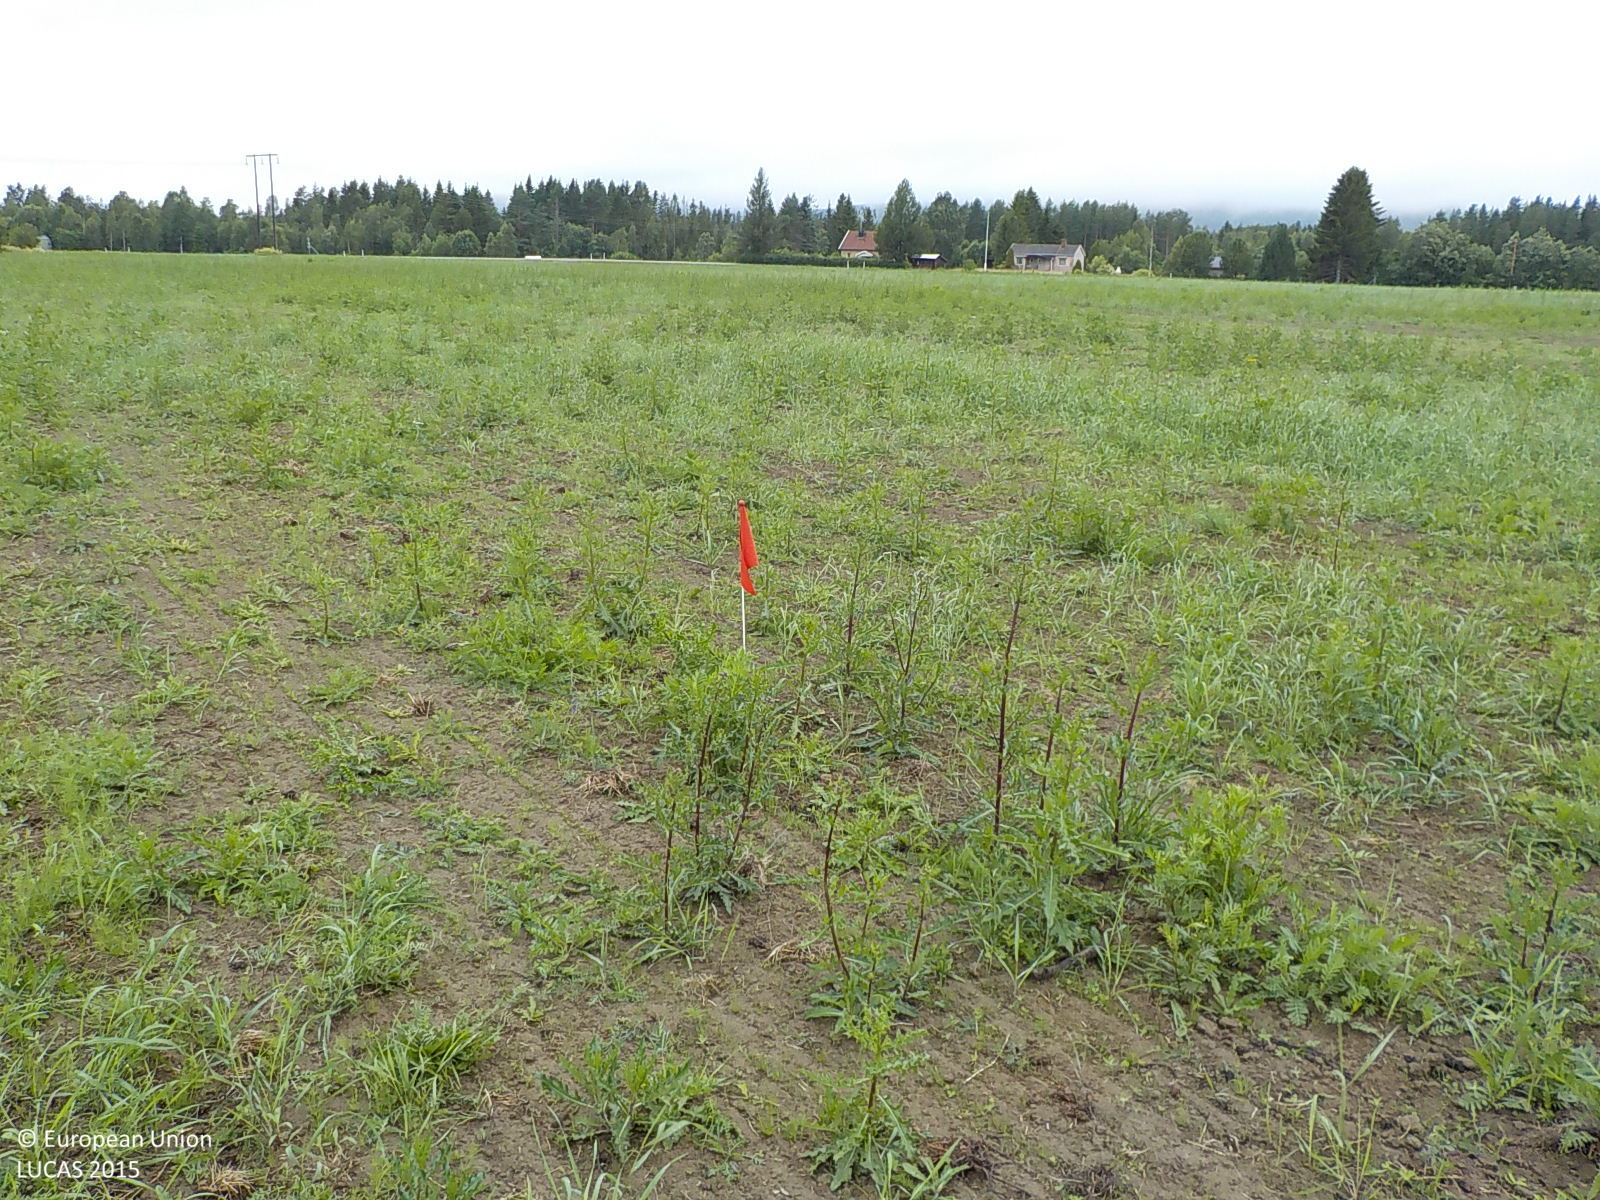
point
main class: Cropland
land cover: Other leguminous and mixtures for fodder
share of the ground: > 75 %
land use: Agriculture (excluding fallow land and kitchen gardens)
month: July
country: SE
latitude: 63.0255
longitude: 17.8226
